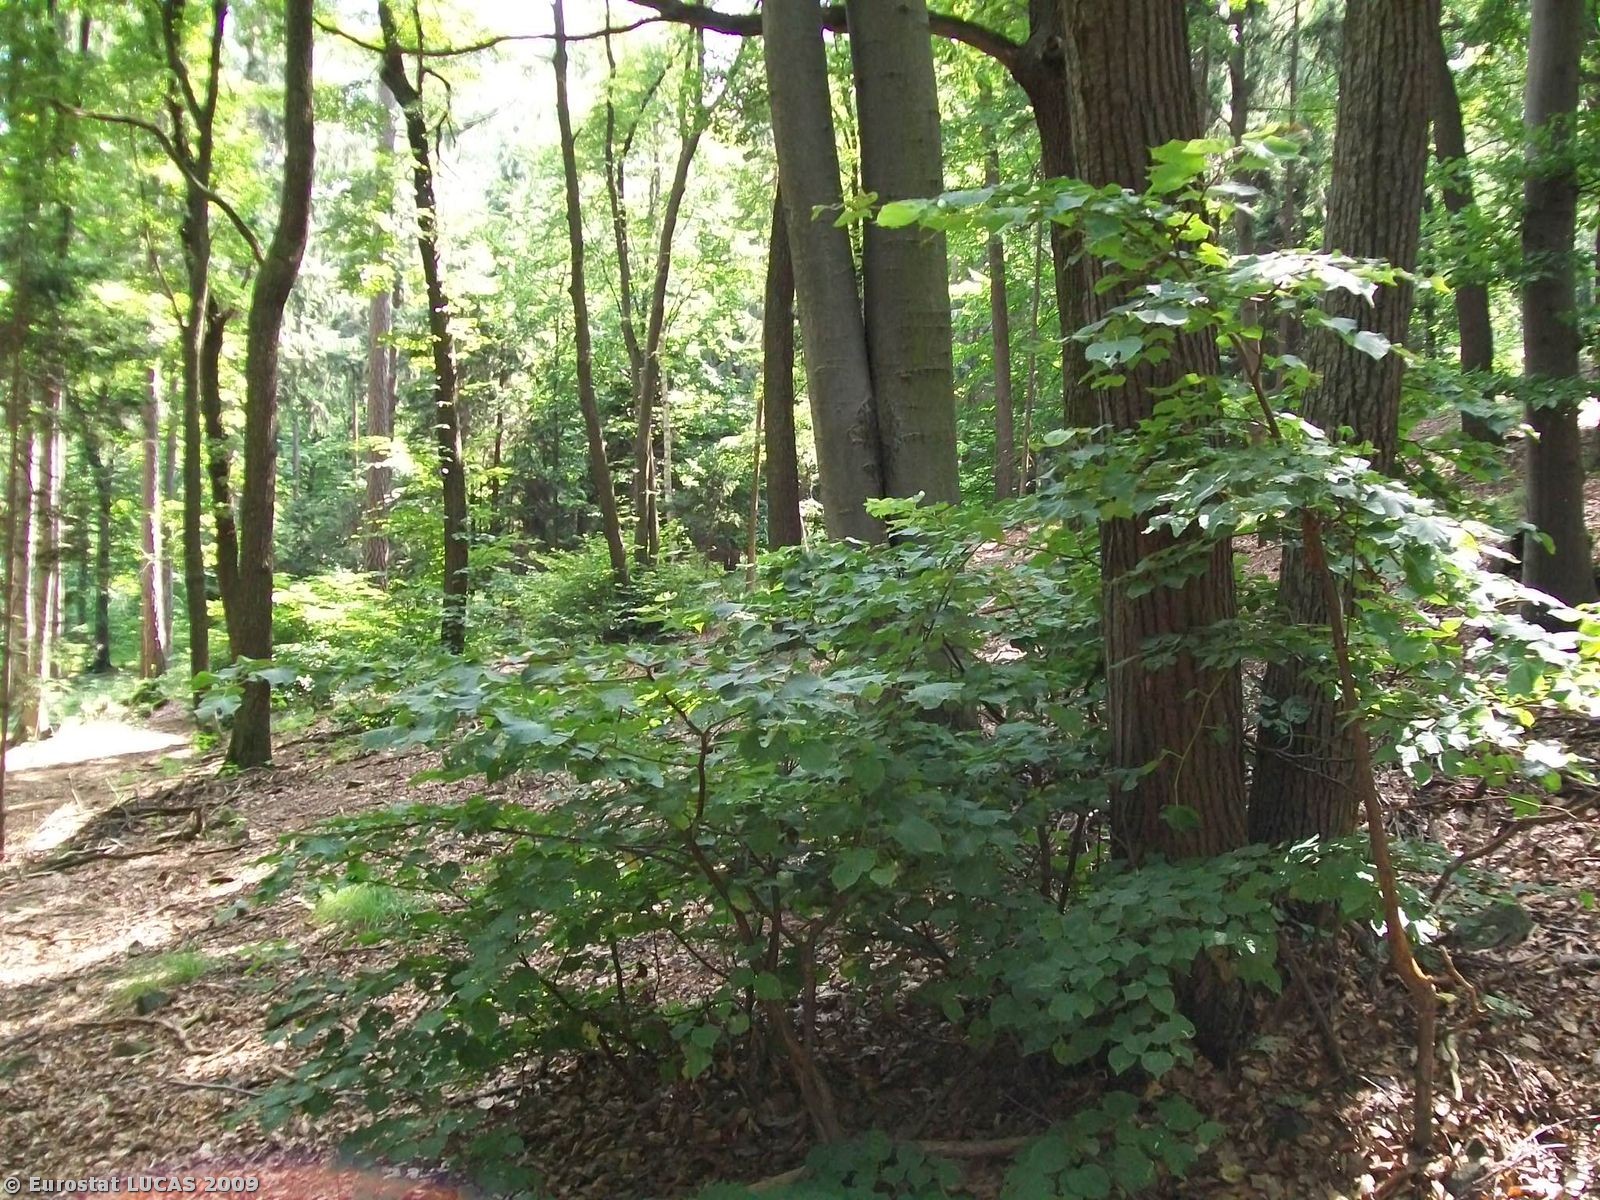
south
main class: Woodland
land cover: Broadleaved woodland
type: beech forest
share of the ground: > 75 %
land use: Amenities, museums, leisure
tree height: > 5 m
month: August
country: PL
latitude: 50.8874
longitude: 16.7326
